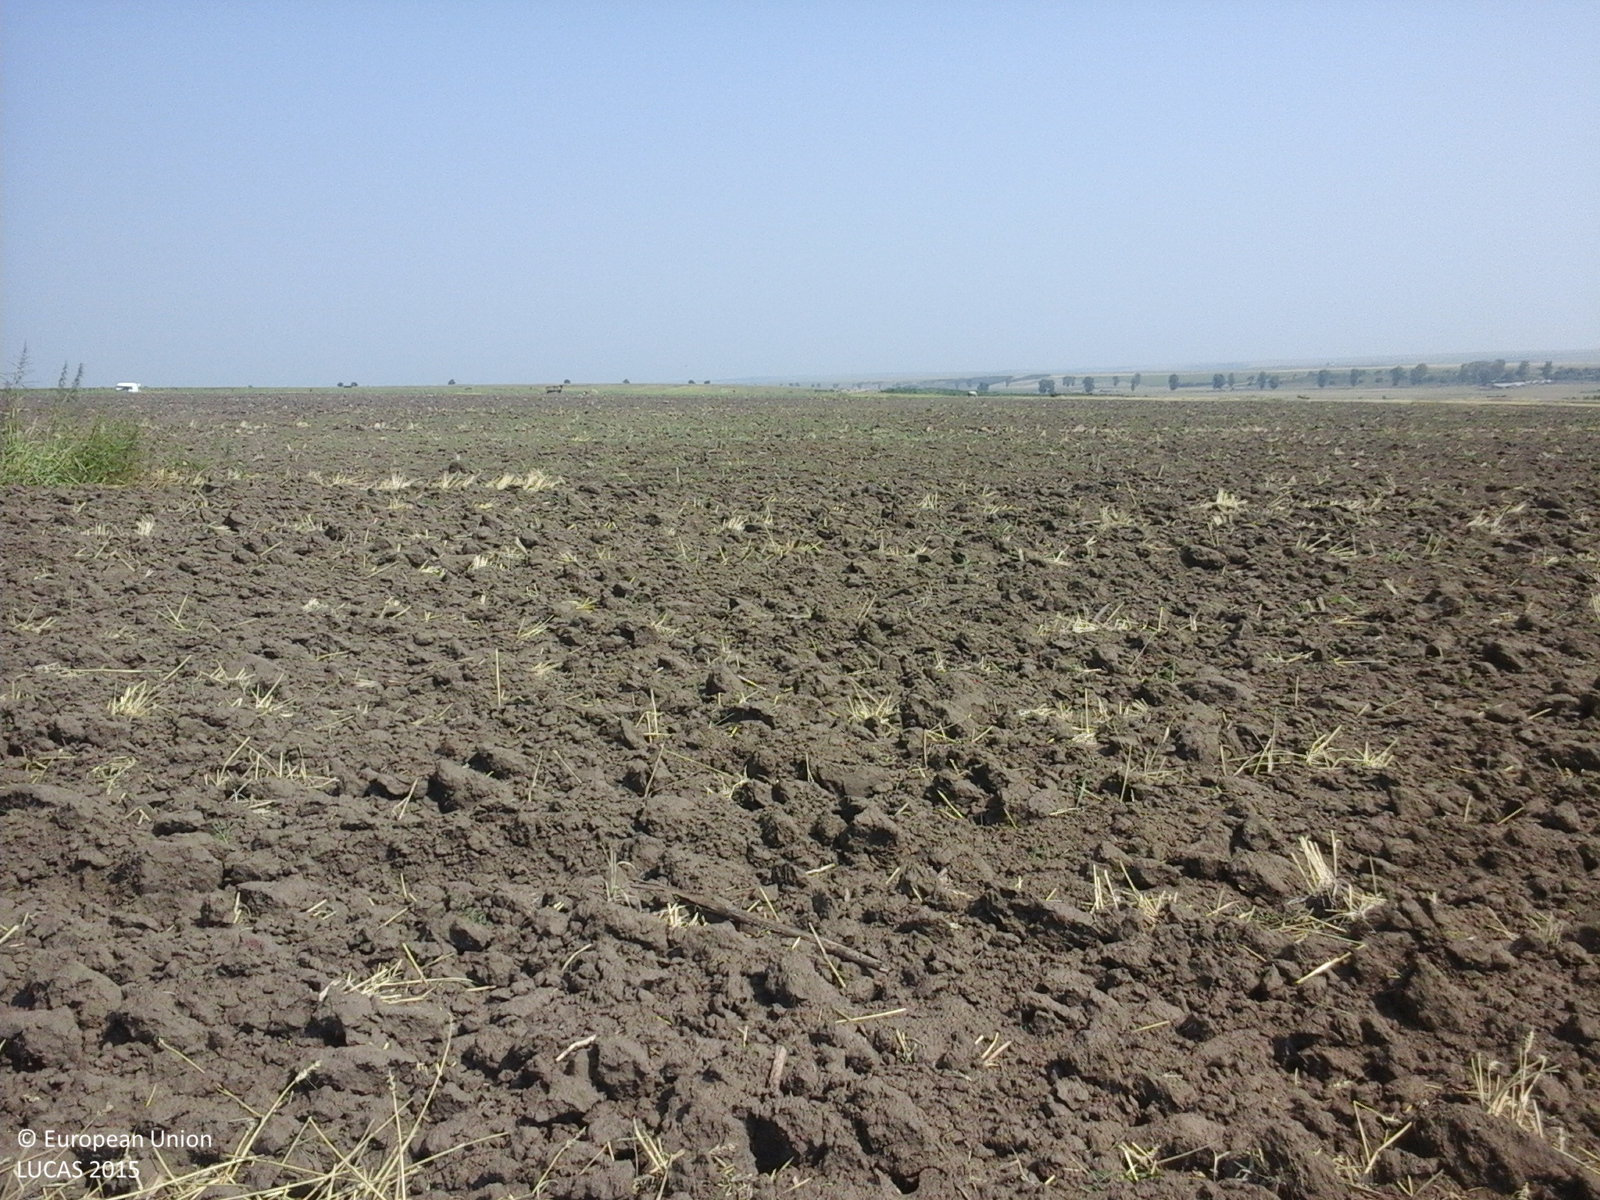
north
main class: Cropland
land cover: Common wheat
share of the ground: < 10 %
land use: Agriculture (excluding fallow land and kitchen gardens)
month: July
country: RO
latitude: 45.6907
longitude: 27.6892
